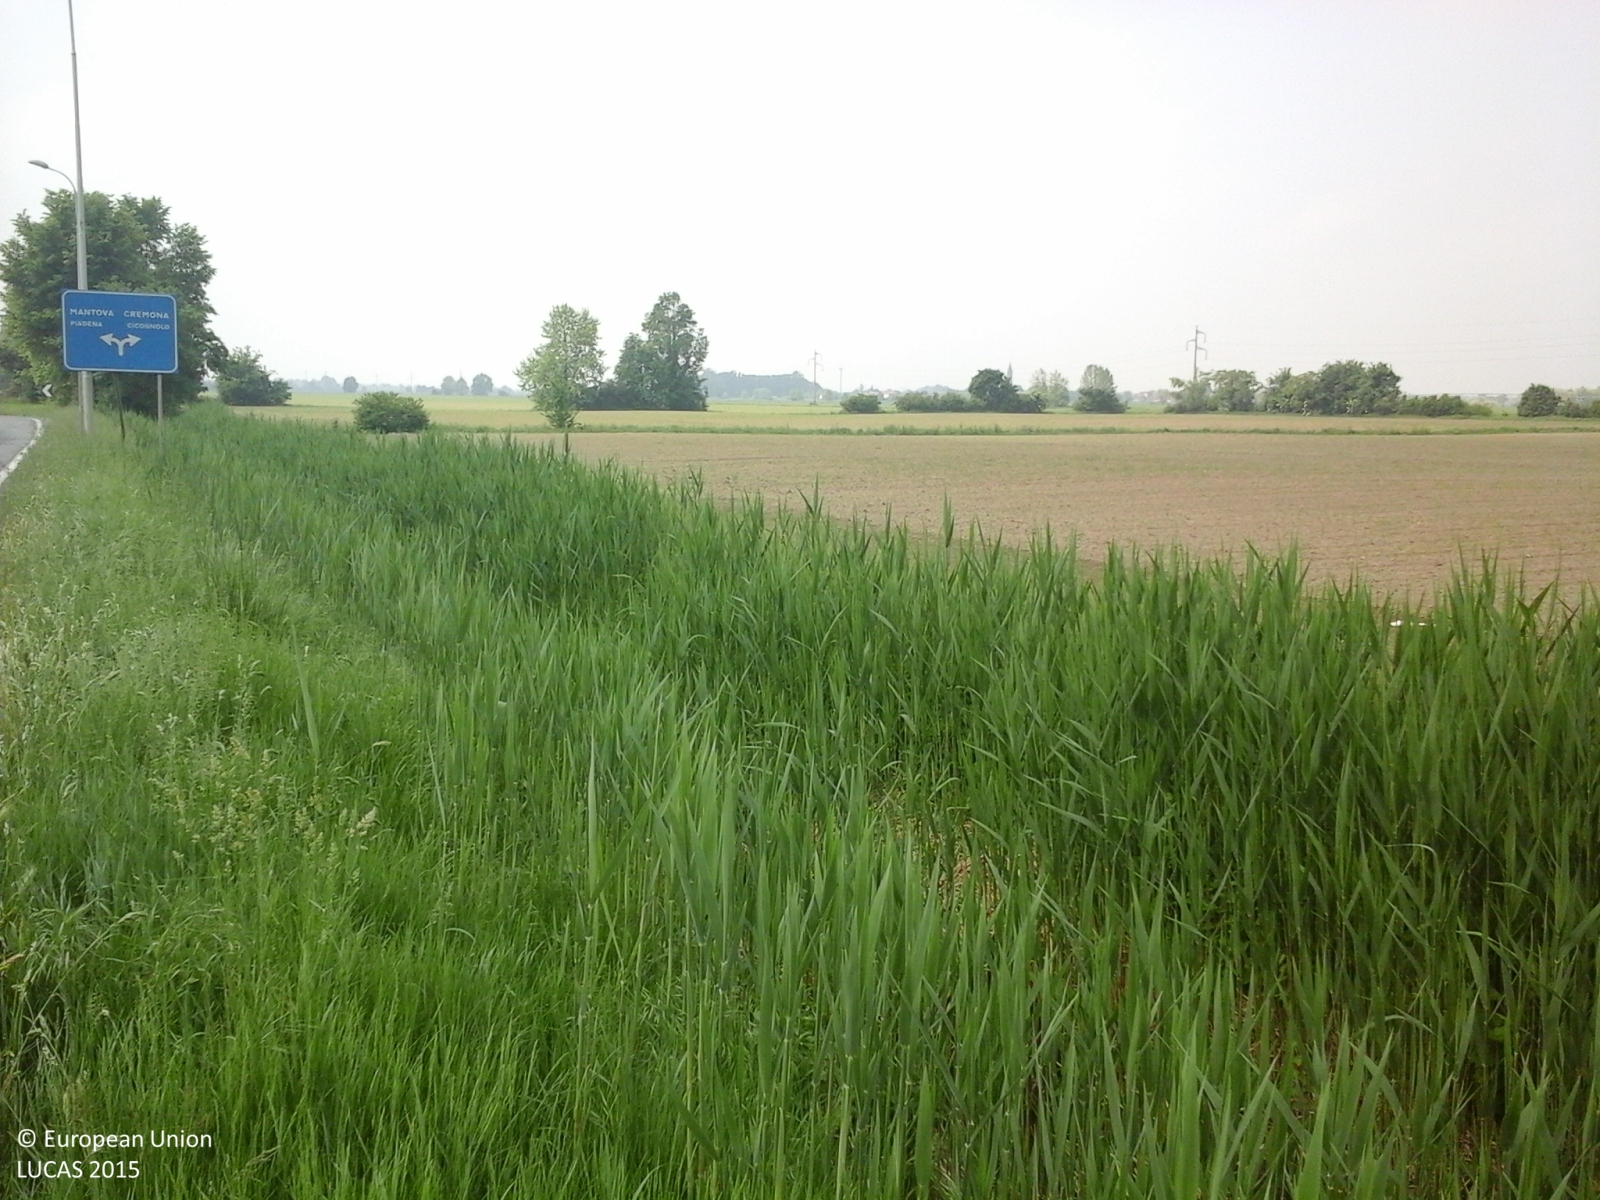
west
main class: Cropland
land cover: Maize
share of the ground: < 10 %
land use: Agriculture (excluding fallow land and kitchen gardens)
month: May
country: IT
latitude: 45.1796
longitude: 10.2667
